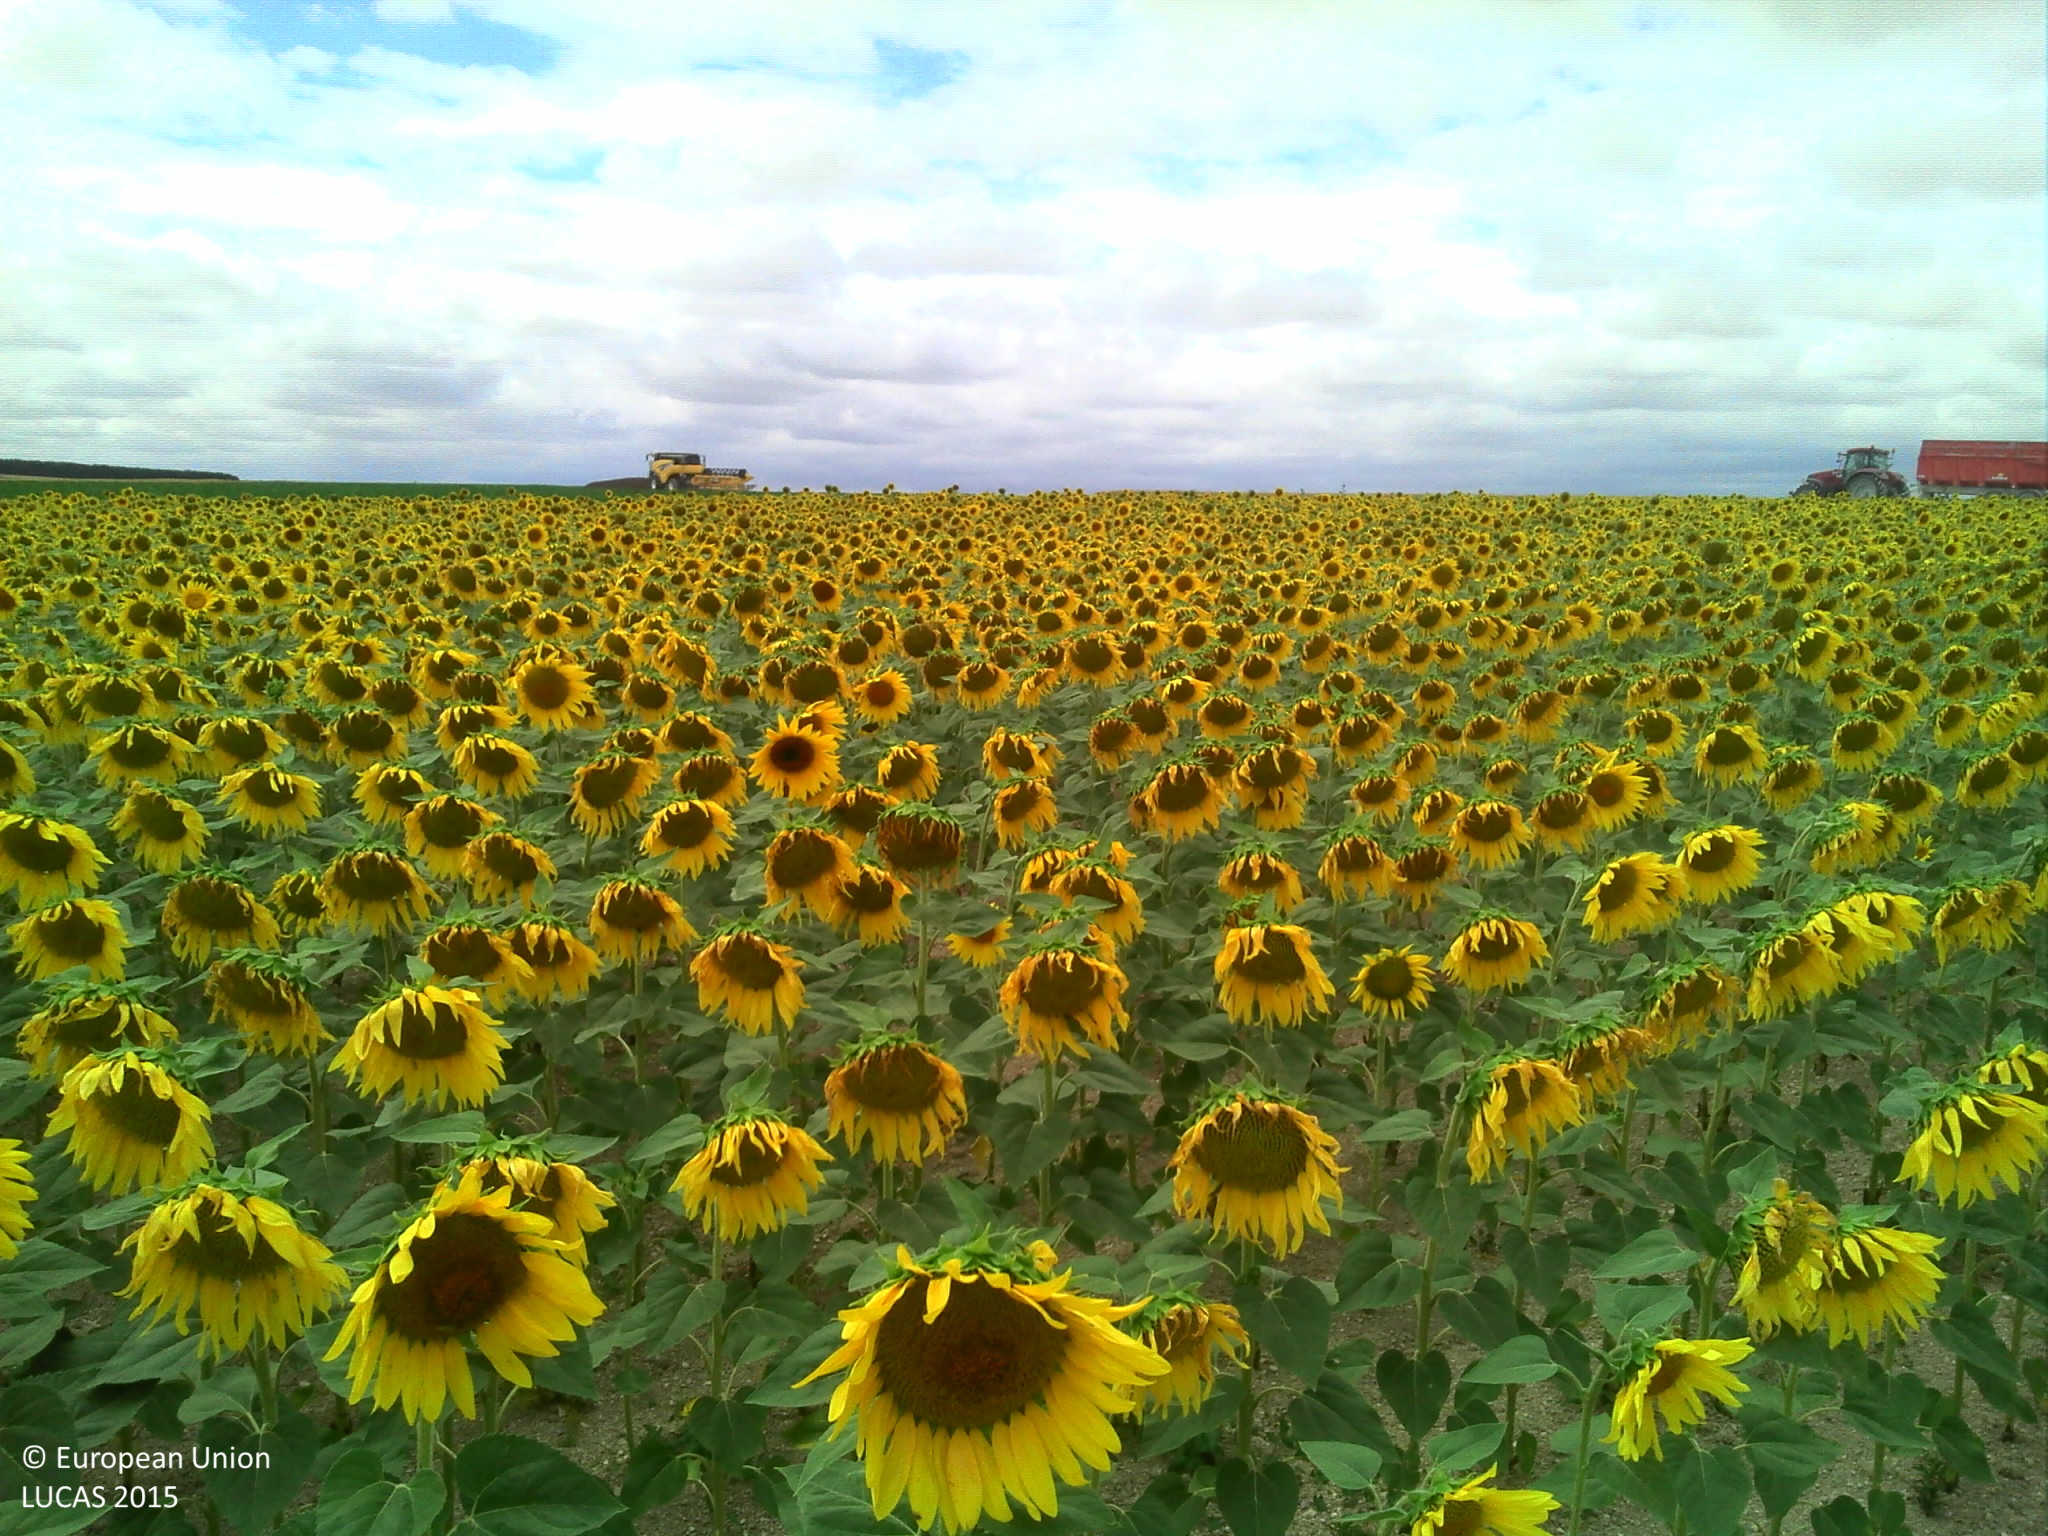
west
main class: Cropland
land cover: Sunflower
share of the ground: > 75 %
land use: Agriculture (excluding fallow land and kitchen gardens)
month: July
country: FR
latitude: 48.8274
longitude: 4.1794
